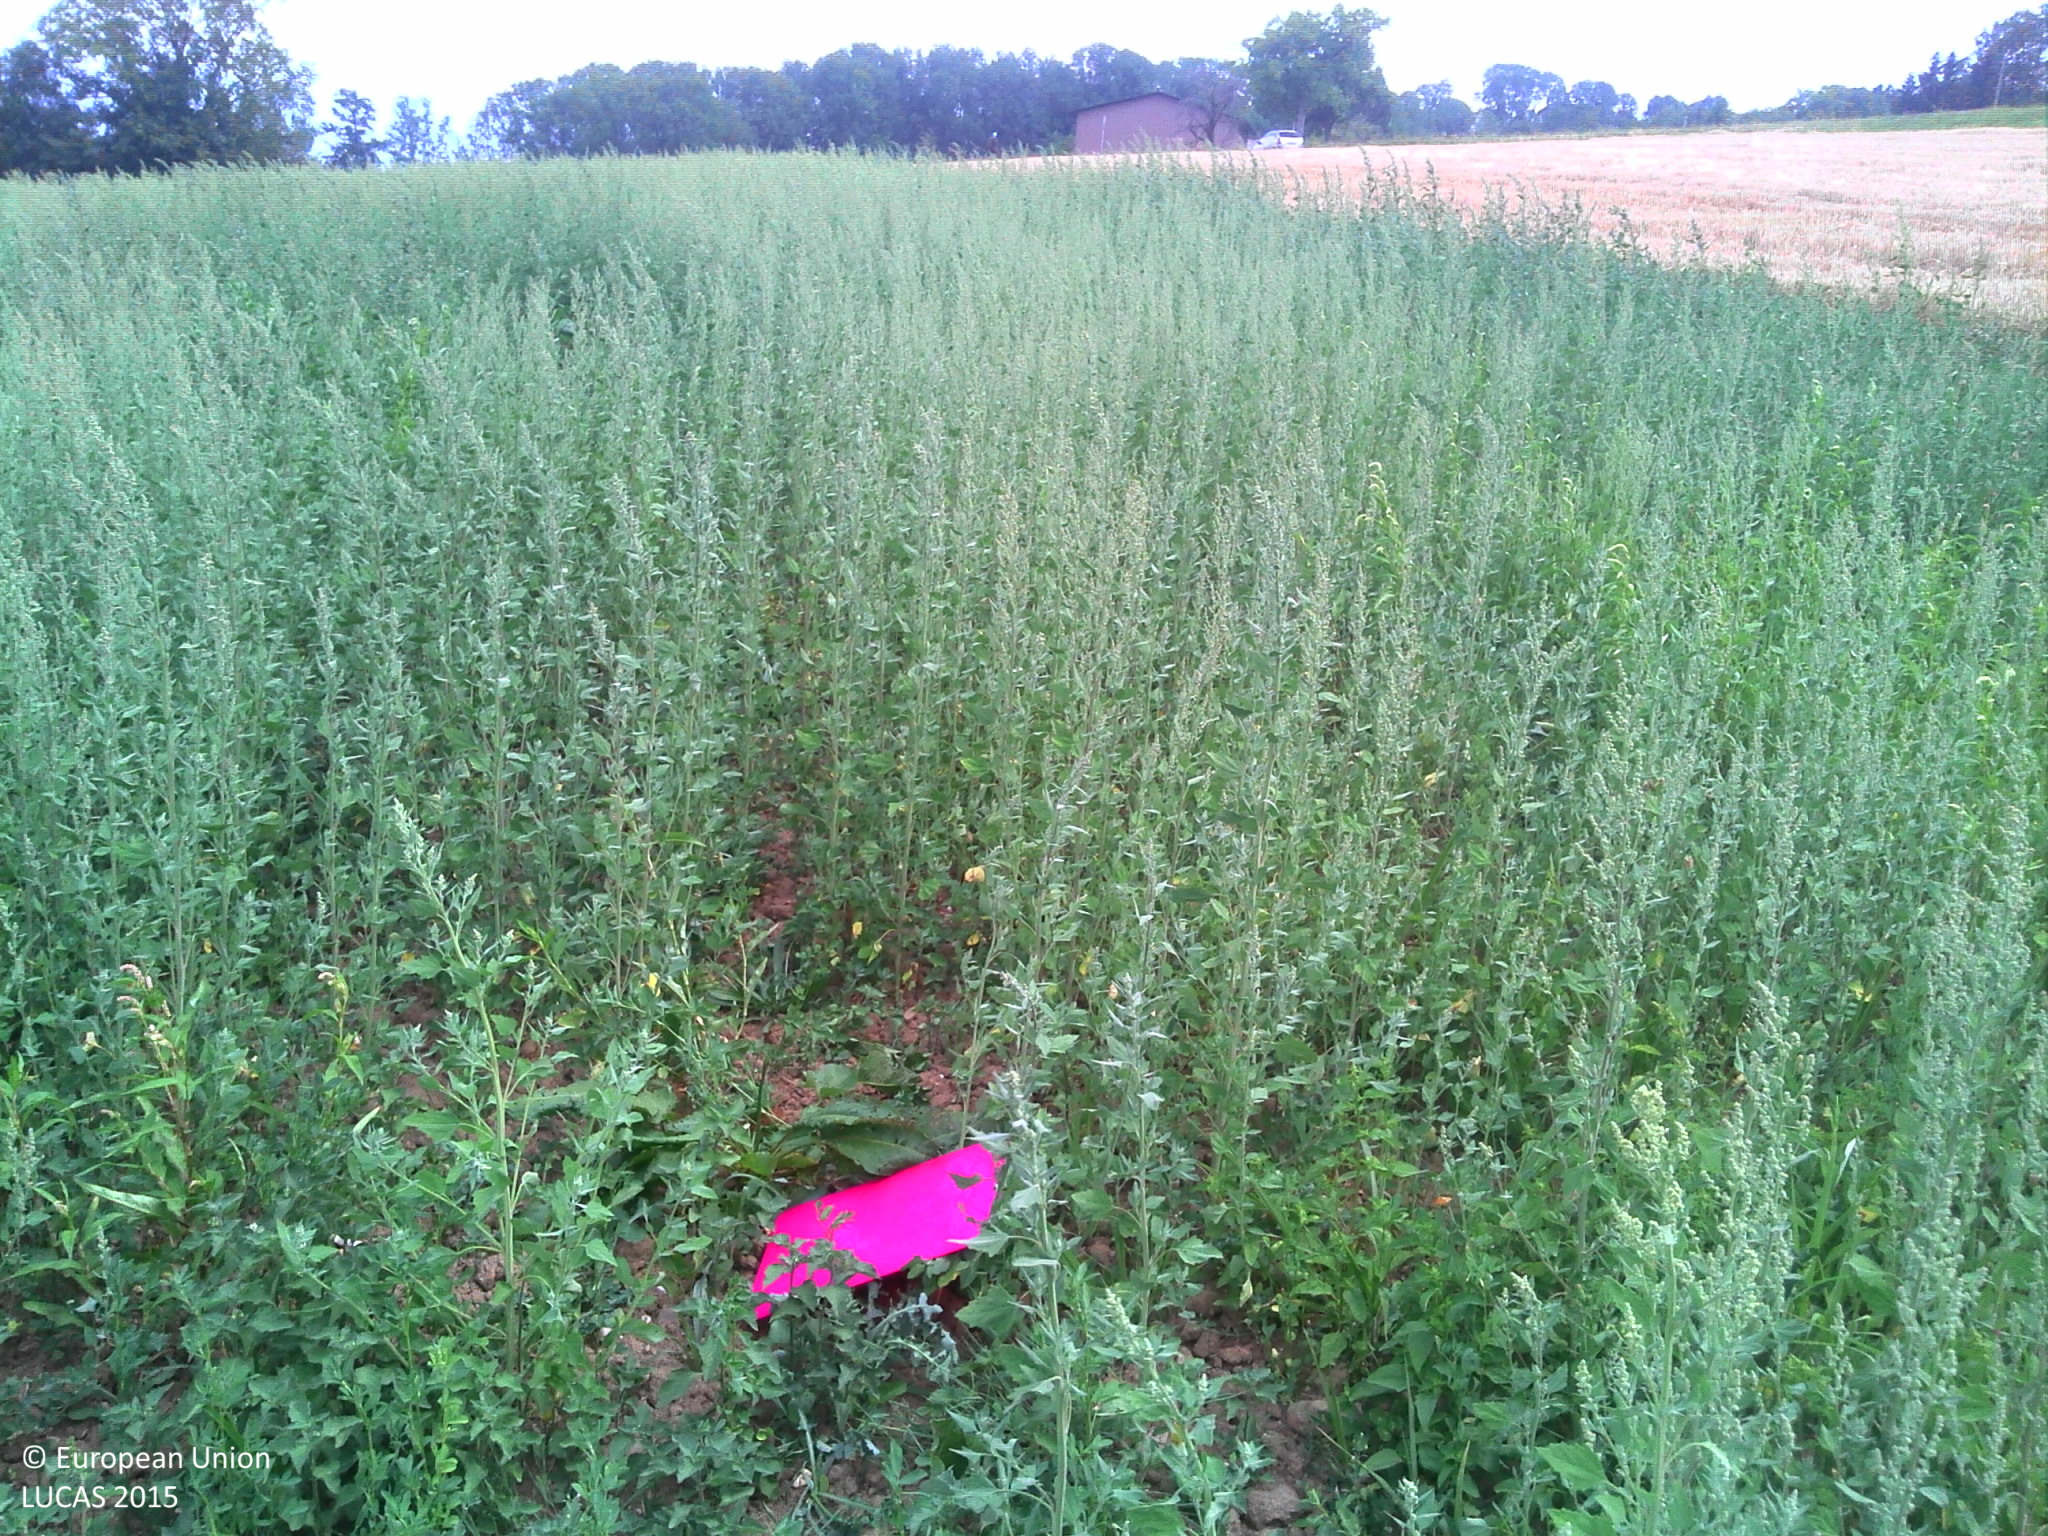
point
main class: Grassland
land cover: Spontaneously vegetated surfaces
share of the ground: > 75 %
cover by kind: herbaceous plants 100 %
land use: Agriculture (excluding fallow land and kitchen gardens)
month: July
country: FR
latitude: 45.9922
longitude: 6.1177
